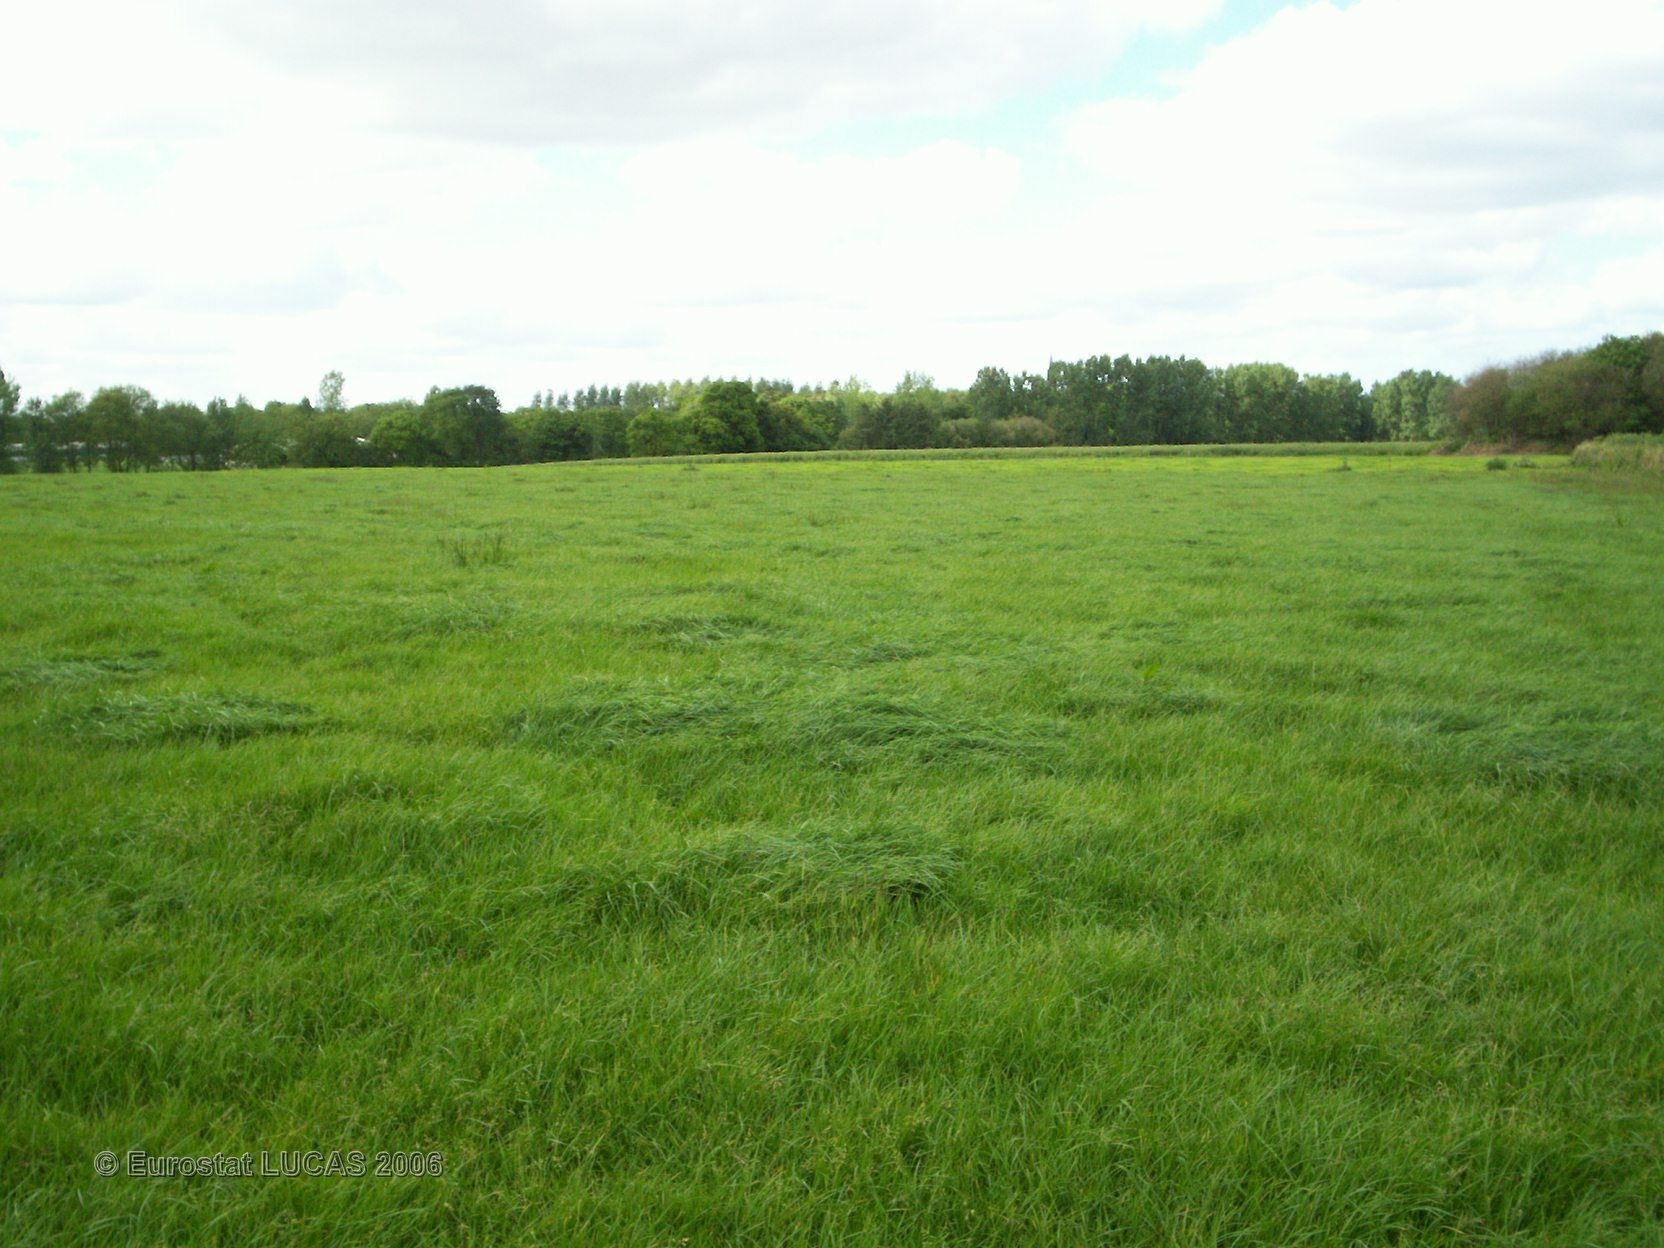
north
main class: Grassland
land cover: Grassland without tree/shrub cover
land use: Agriculture (excluding fallow land and kitchen gardens)
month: May
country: FR
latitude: 48.5248
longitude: -3.0011
